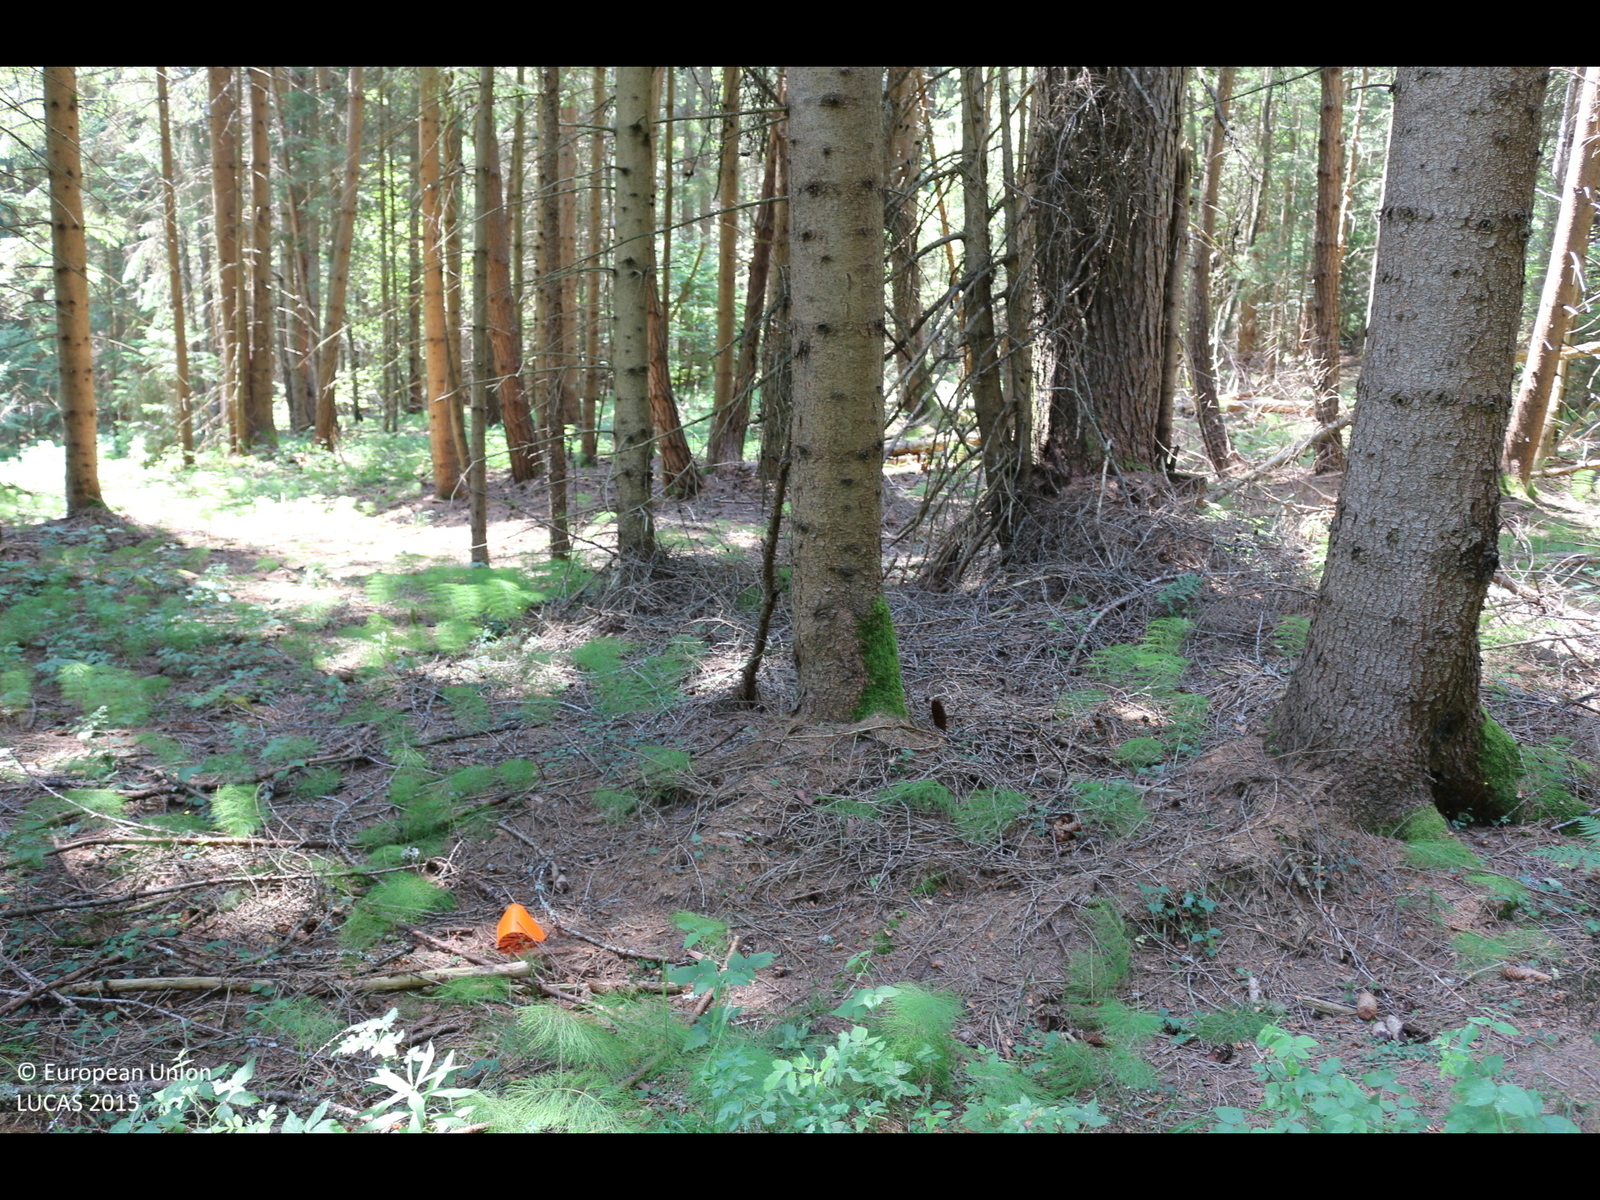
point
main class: Woodland
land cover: Spruce dominated coniferous woodland
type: alpine coniferous forest
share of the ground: > 75 %
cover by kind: coniferous forest trees 95 %, broadleaved forest trees 5 %
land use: Forestry
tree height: > 5 m
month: July
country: AT
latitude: 46.7796
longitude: 14.0447
